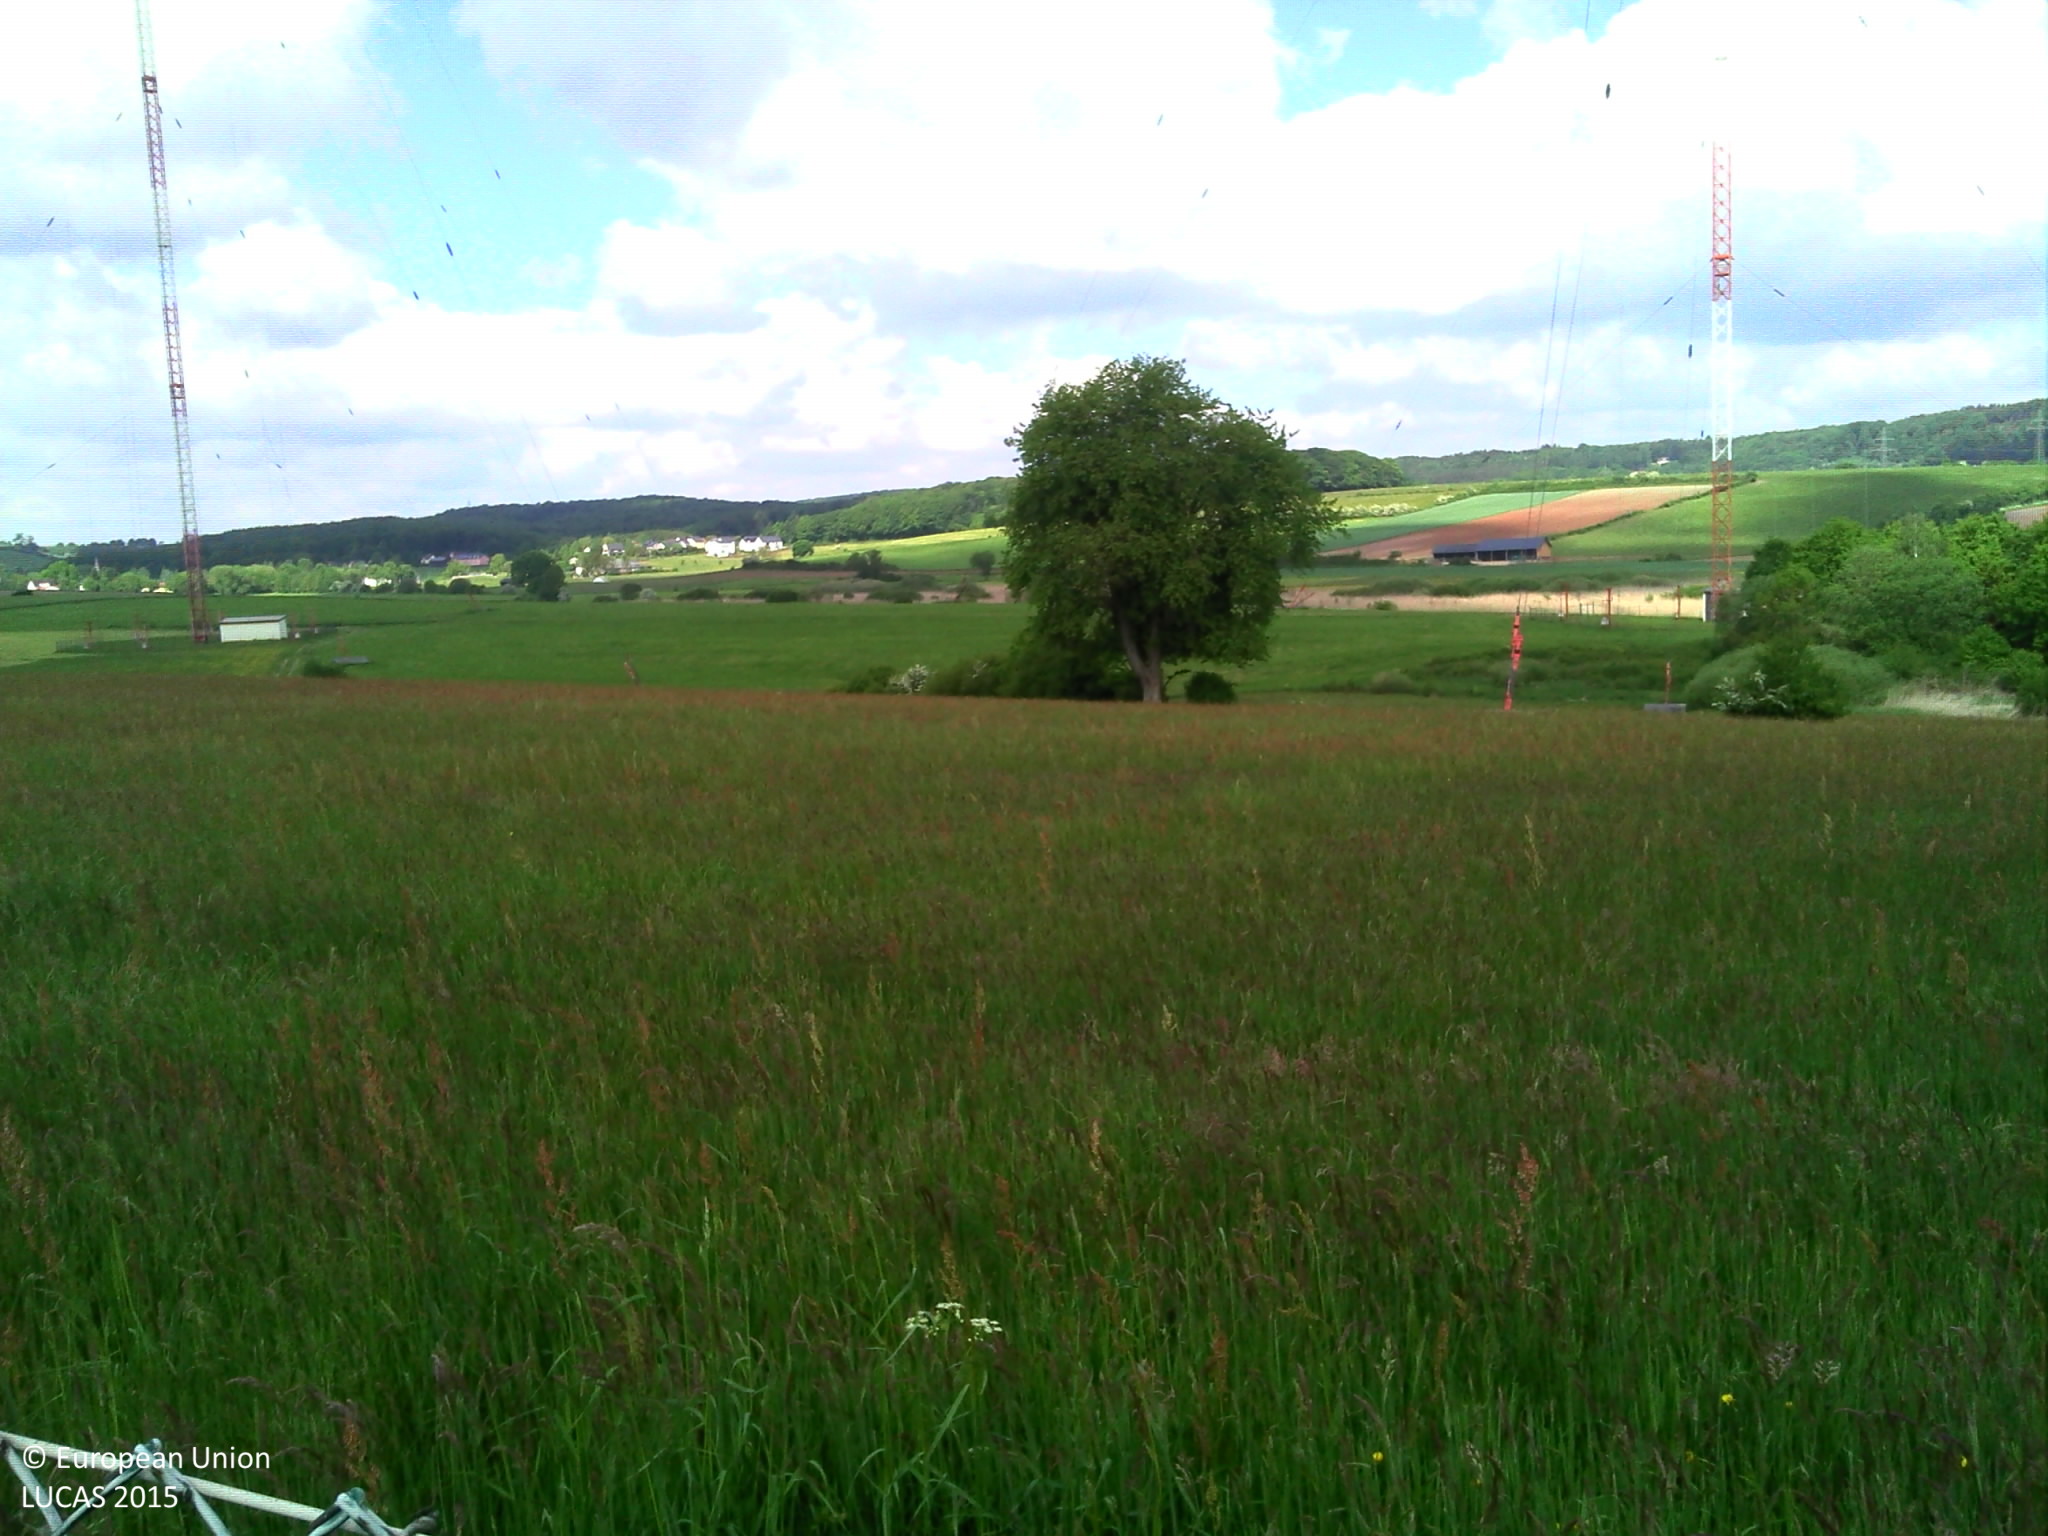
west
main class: Grassland
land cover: Grassland without tree/shrub cover
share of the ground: > 75 %
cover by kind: herbaceous plants 100 %
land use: Agriculture (excluding fallow land and kitchen gardens)
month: May
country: LU
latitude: 49.7289
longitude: 6.3232
